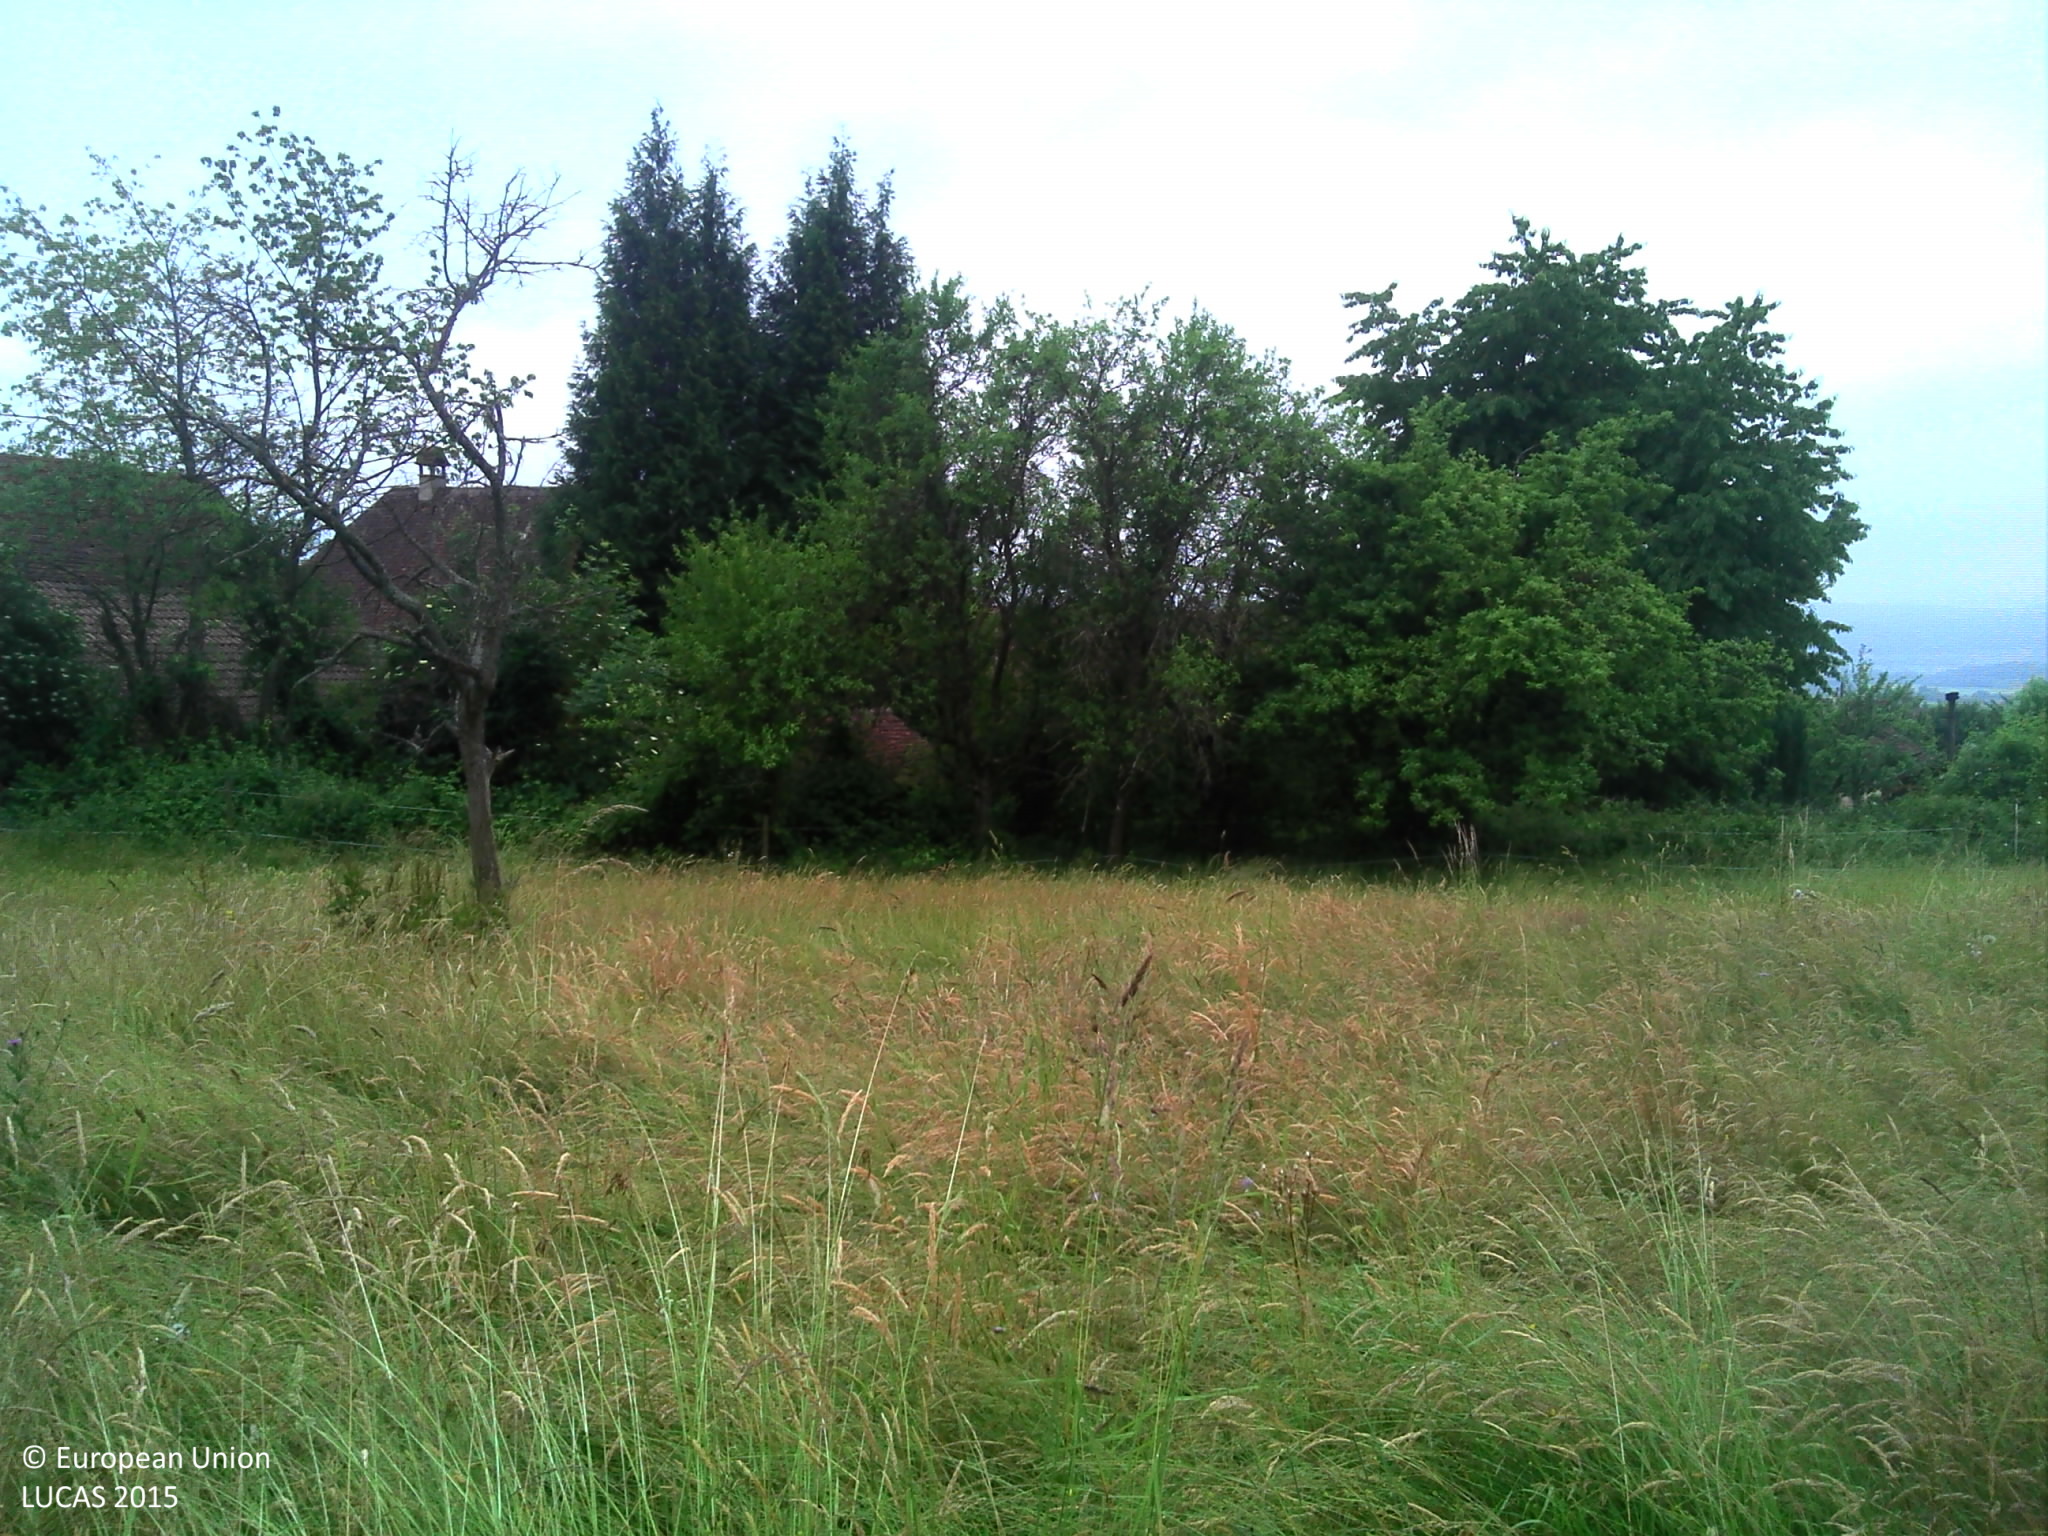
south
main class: Grassland
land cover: Grassland with sparse tree/shrub cover
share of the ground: > 75 %
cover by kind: herbaceous plants 95 %, broadleaved forest trees 5 %
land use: Agriculture (excluding fallow land and kitchen gardens)
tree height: > 5 m
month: June
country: FR
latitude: 47.5089
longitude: 7.4126
